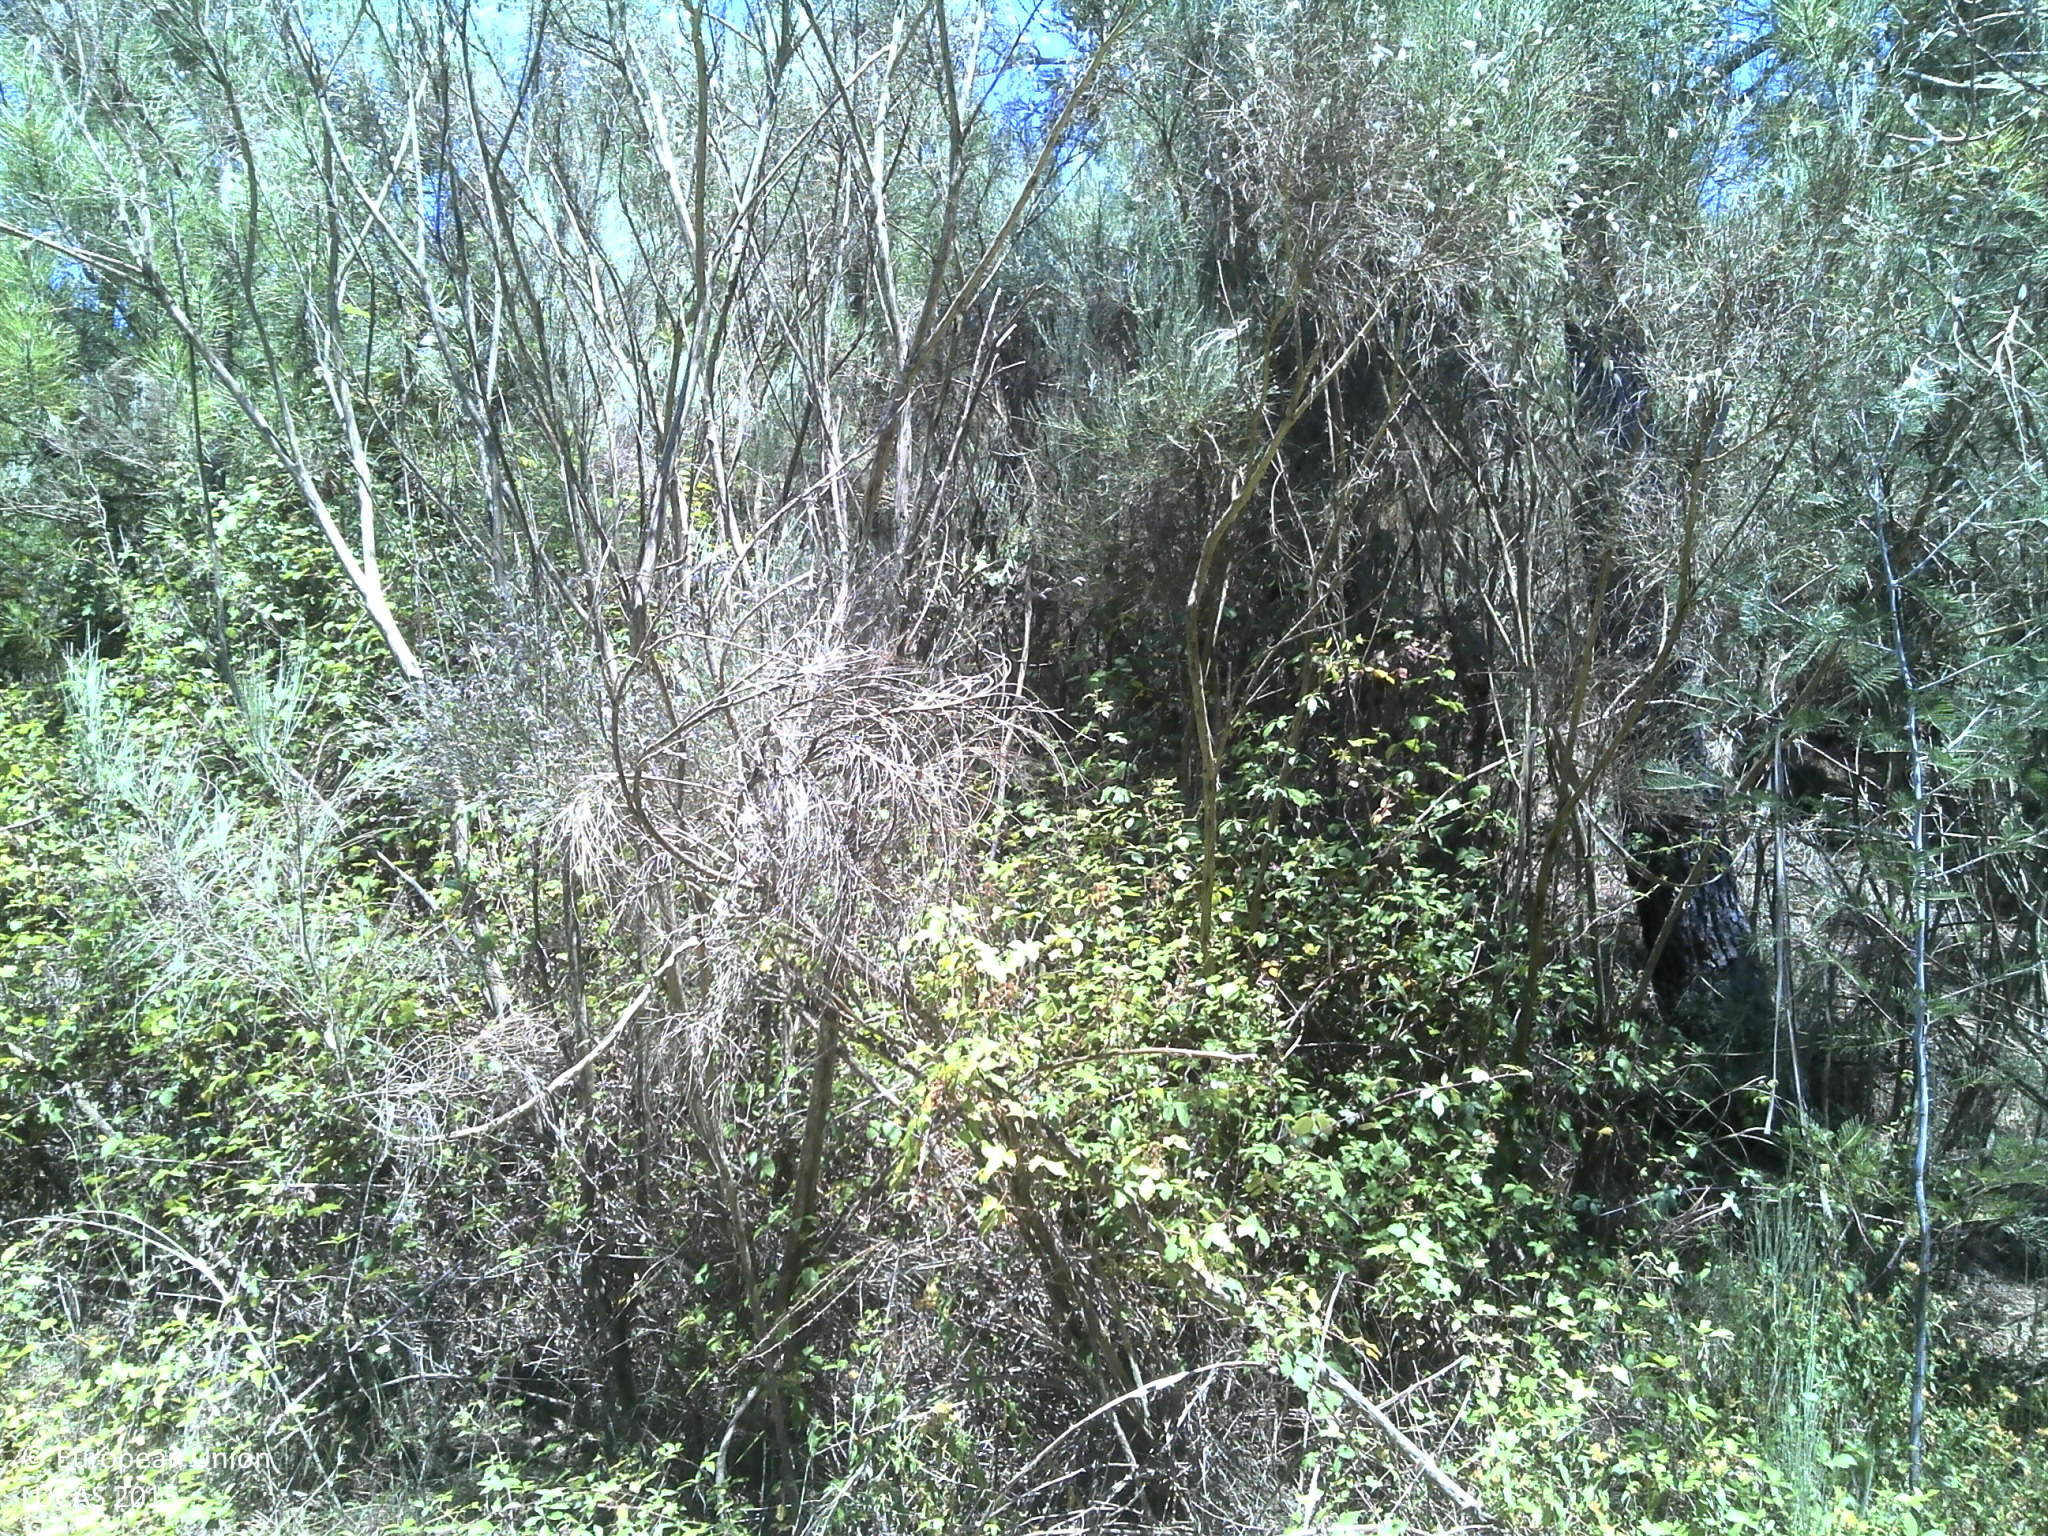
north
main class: Woodland
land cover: Broadleaved woodland
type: exotic forest
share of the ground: > 75 %
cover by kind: broadleaved forest trees 80 %, shrubs 20 %
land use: Abandoned areas
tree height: > 5 m
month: July
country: PT
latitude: 40.2451
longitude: -7.9270
